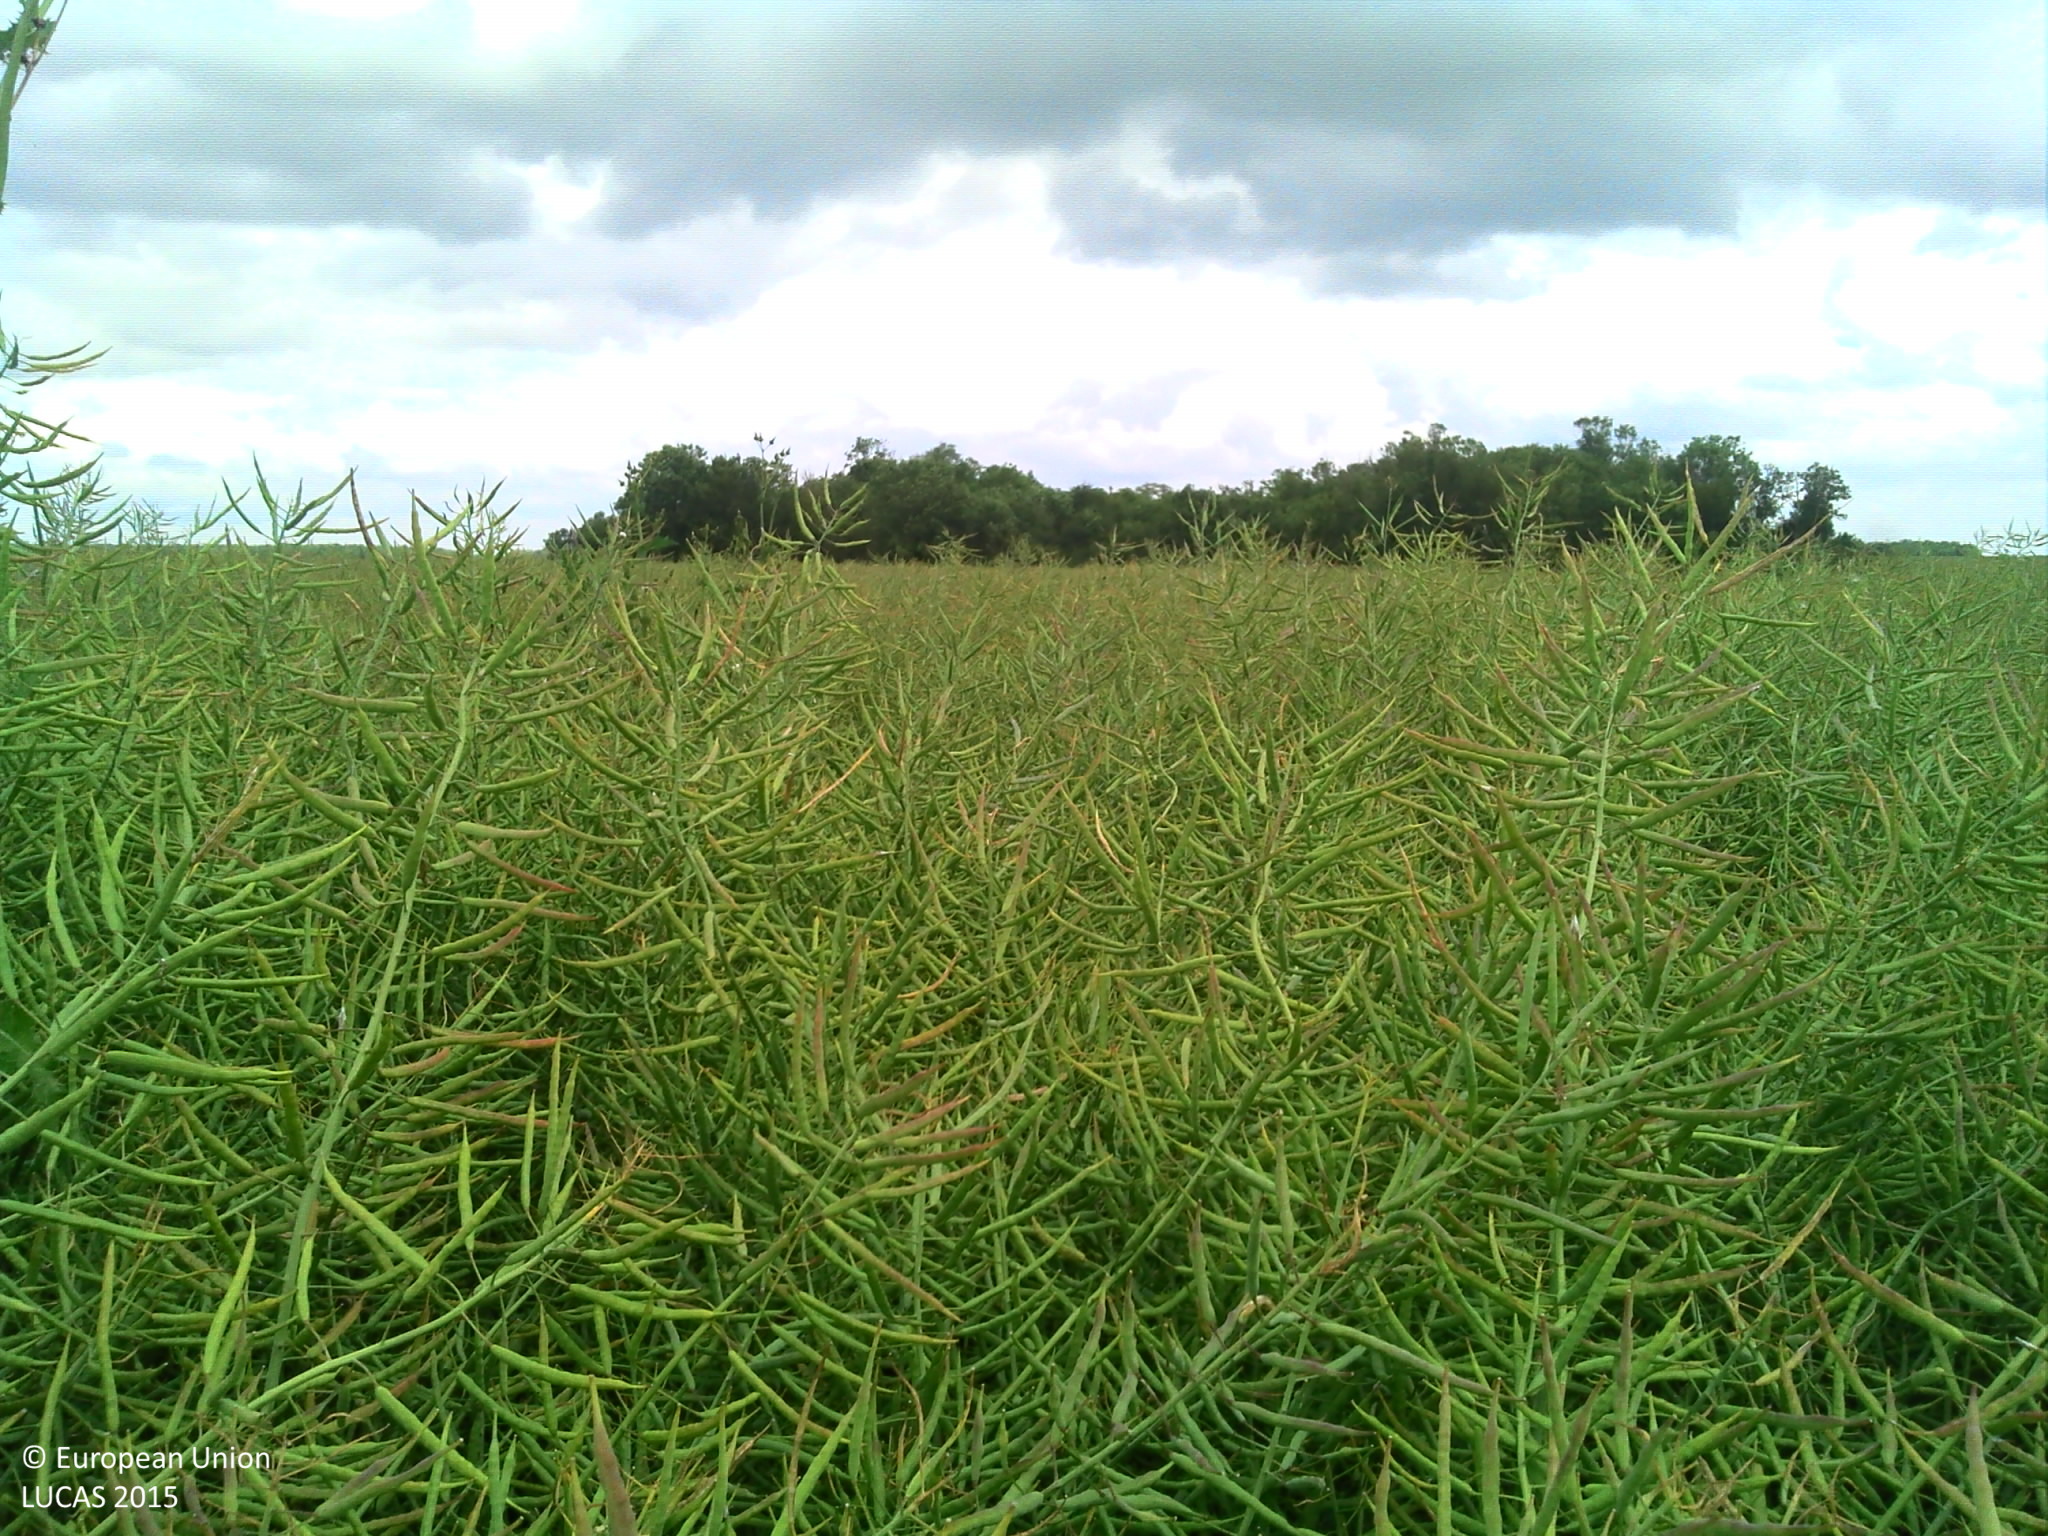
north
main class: Cropland
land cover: Rape and turnip rape
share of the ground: > 75 %
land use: Agriculture (excluding fallow land and kitchen gardens)
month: June
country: FR
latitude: 48.3248
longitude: 1.4457
